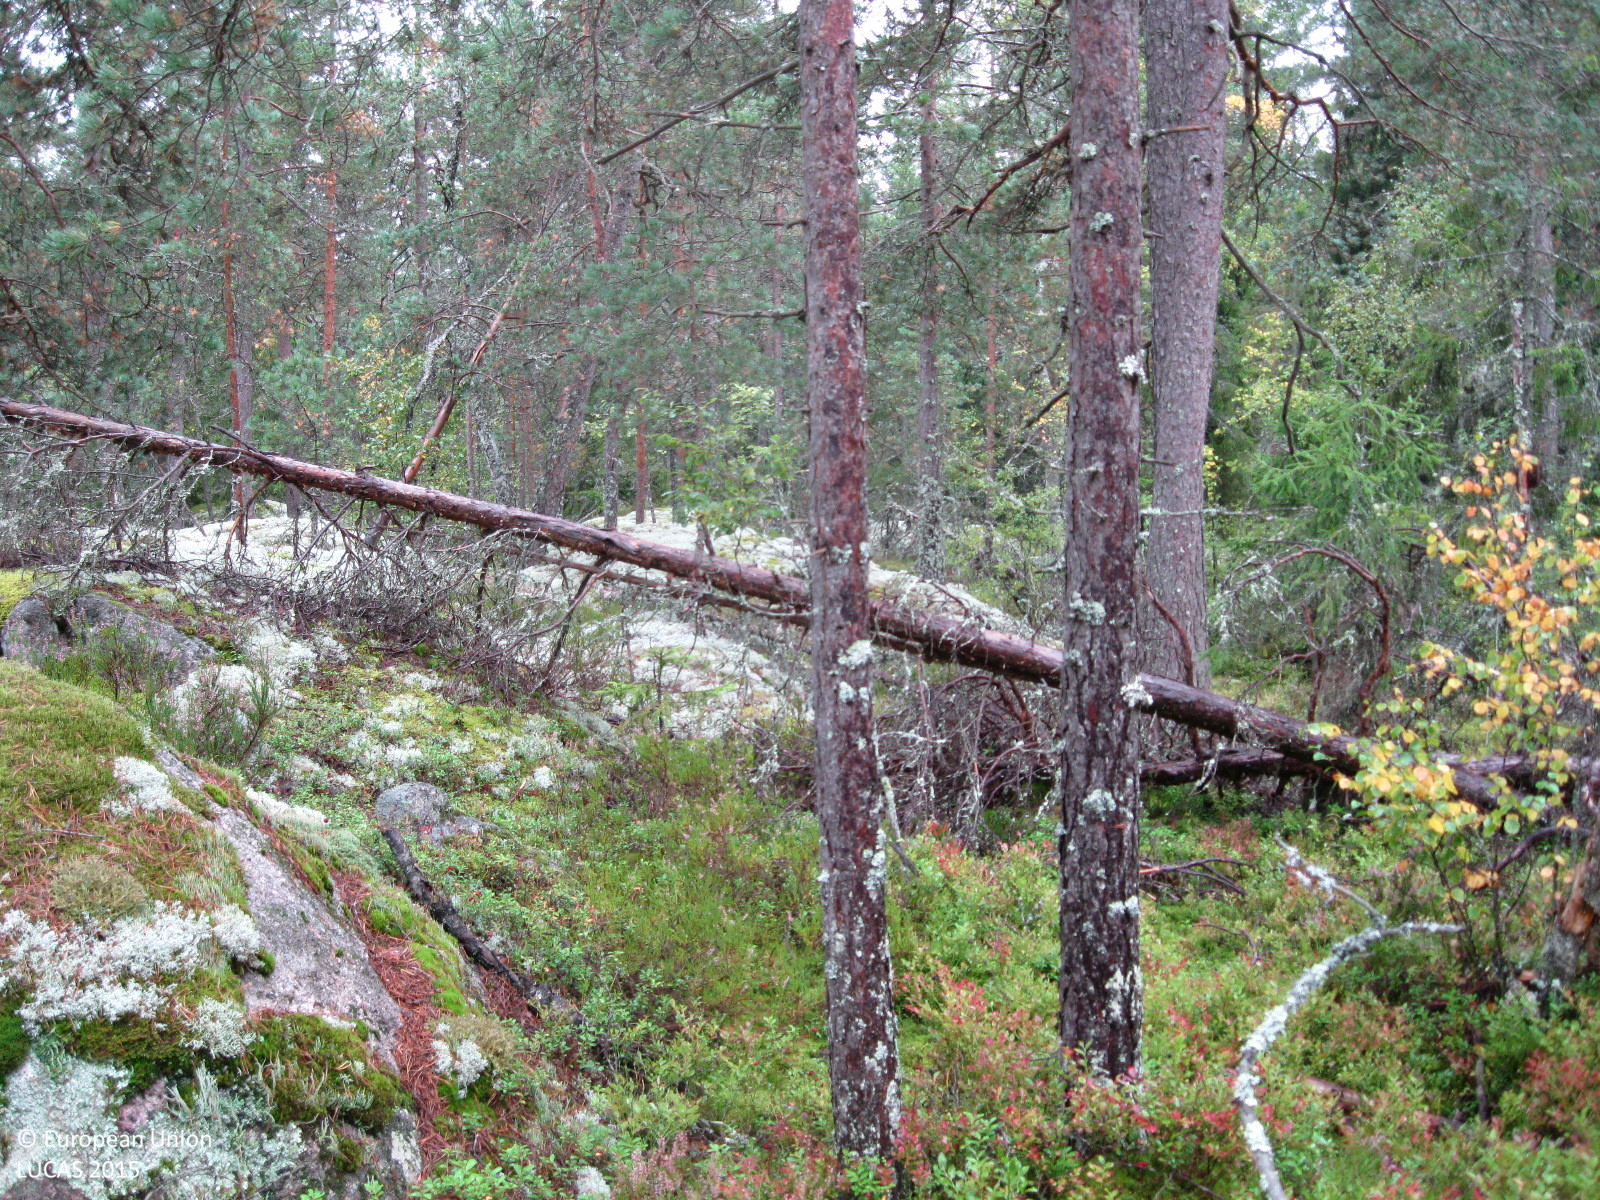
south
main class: Woodland
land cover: Pine dominated coniferous woodland
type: boreal forest
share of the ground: 25 - 50 %
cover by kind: shrubs 50 %, coniferous forest trees 25 %, herbaceous plants 20 %, lichens and mosses 5 %
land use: Forestry
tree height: > 5 m
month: September
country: FI
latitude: 60.2748
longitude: 24.6292
